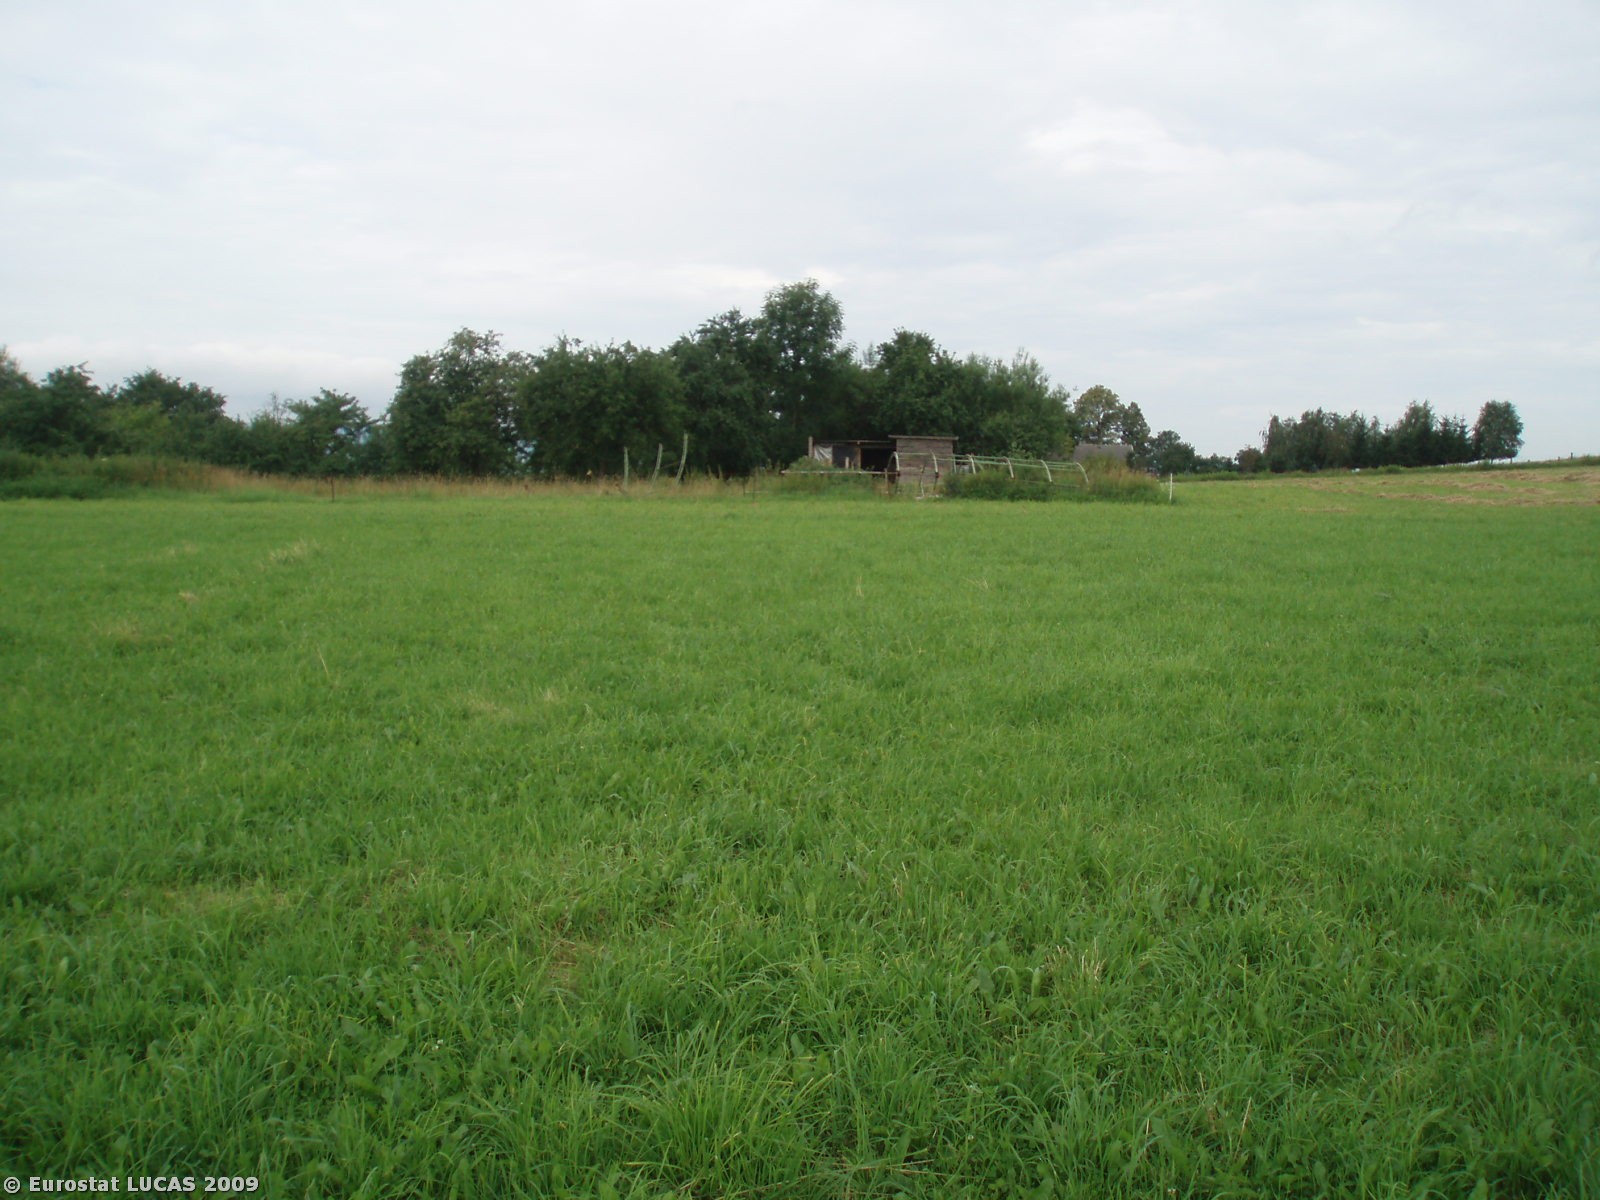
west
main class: Grassland
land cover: Grassland without tree/shrub cover
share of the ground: > 75 %
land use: Agriculture (excluding fallow land and kitchen gardens)
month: July
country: CZ
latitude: 50.8318
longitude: 14.9865
